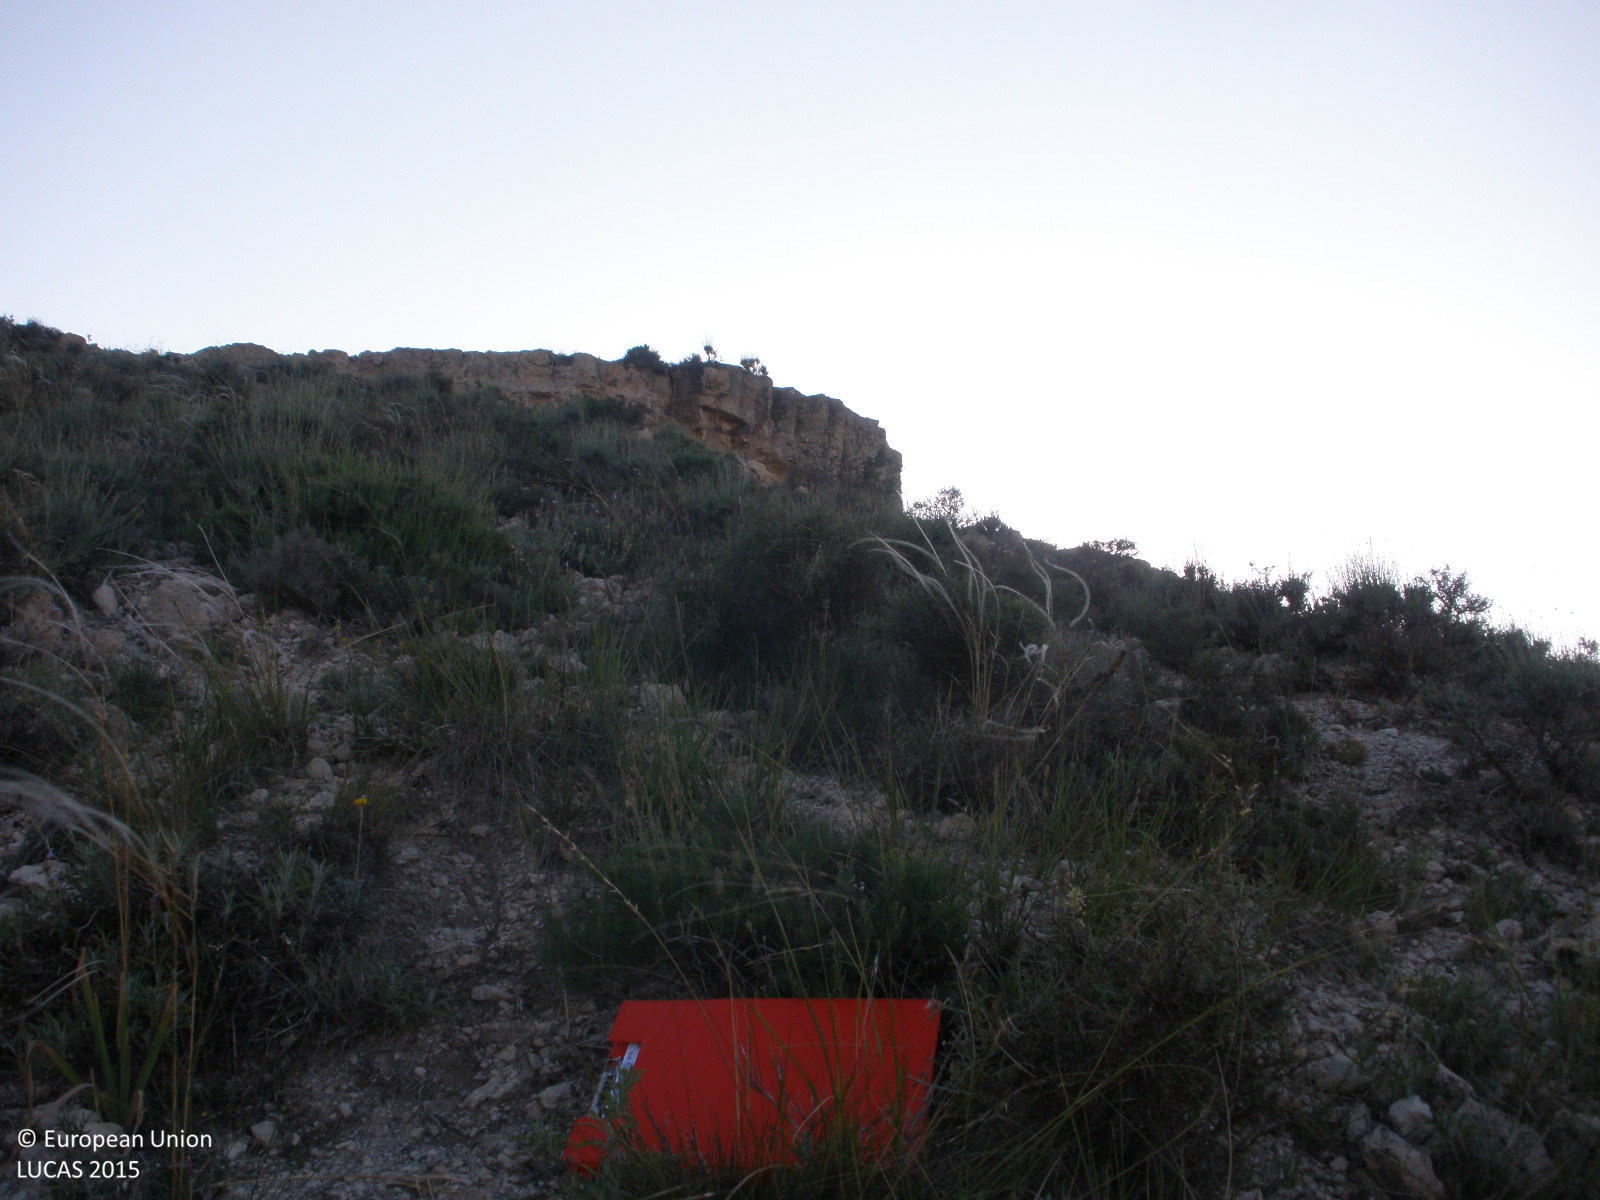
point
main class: Shrubland
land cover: Shrubland without tree cover
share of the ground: 25 - 50 %
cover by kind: shrubs 40 %, herbaceous plants 30 %, consolidated bare surface 30 %
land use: Agriculture (excluding fallow land and kitchen gardens)
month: June
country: ES
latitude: 40.4991
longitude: -1.0444
